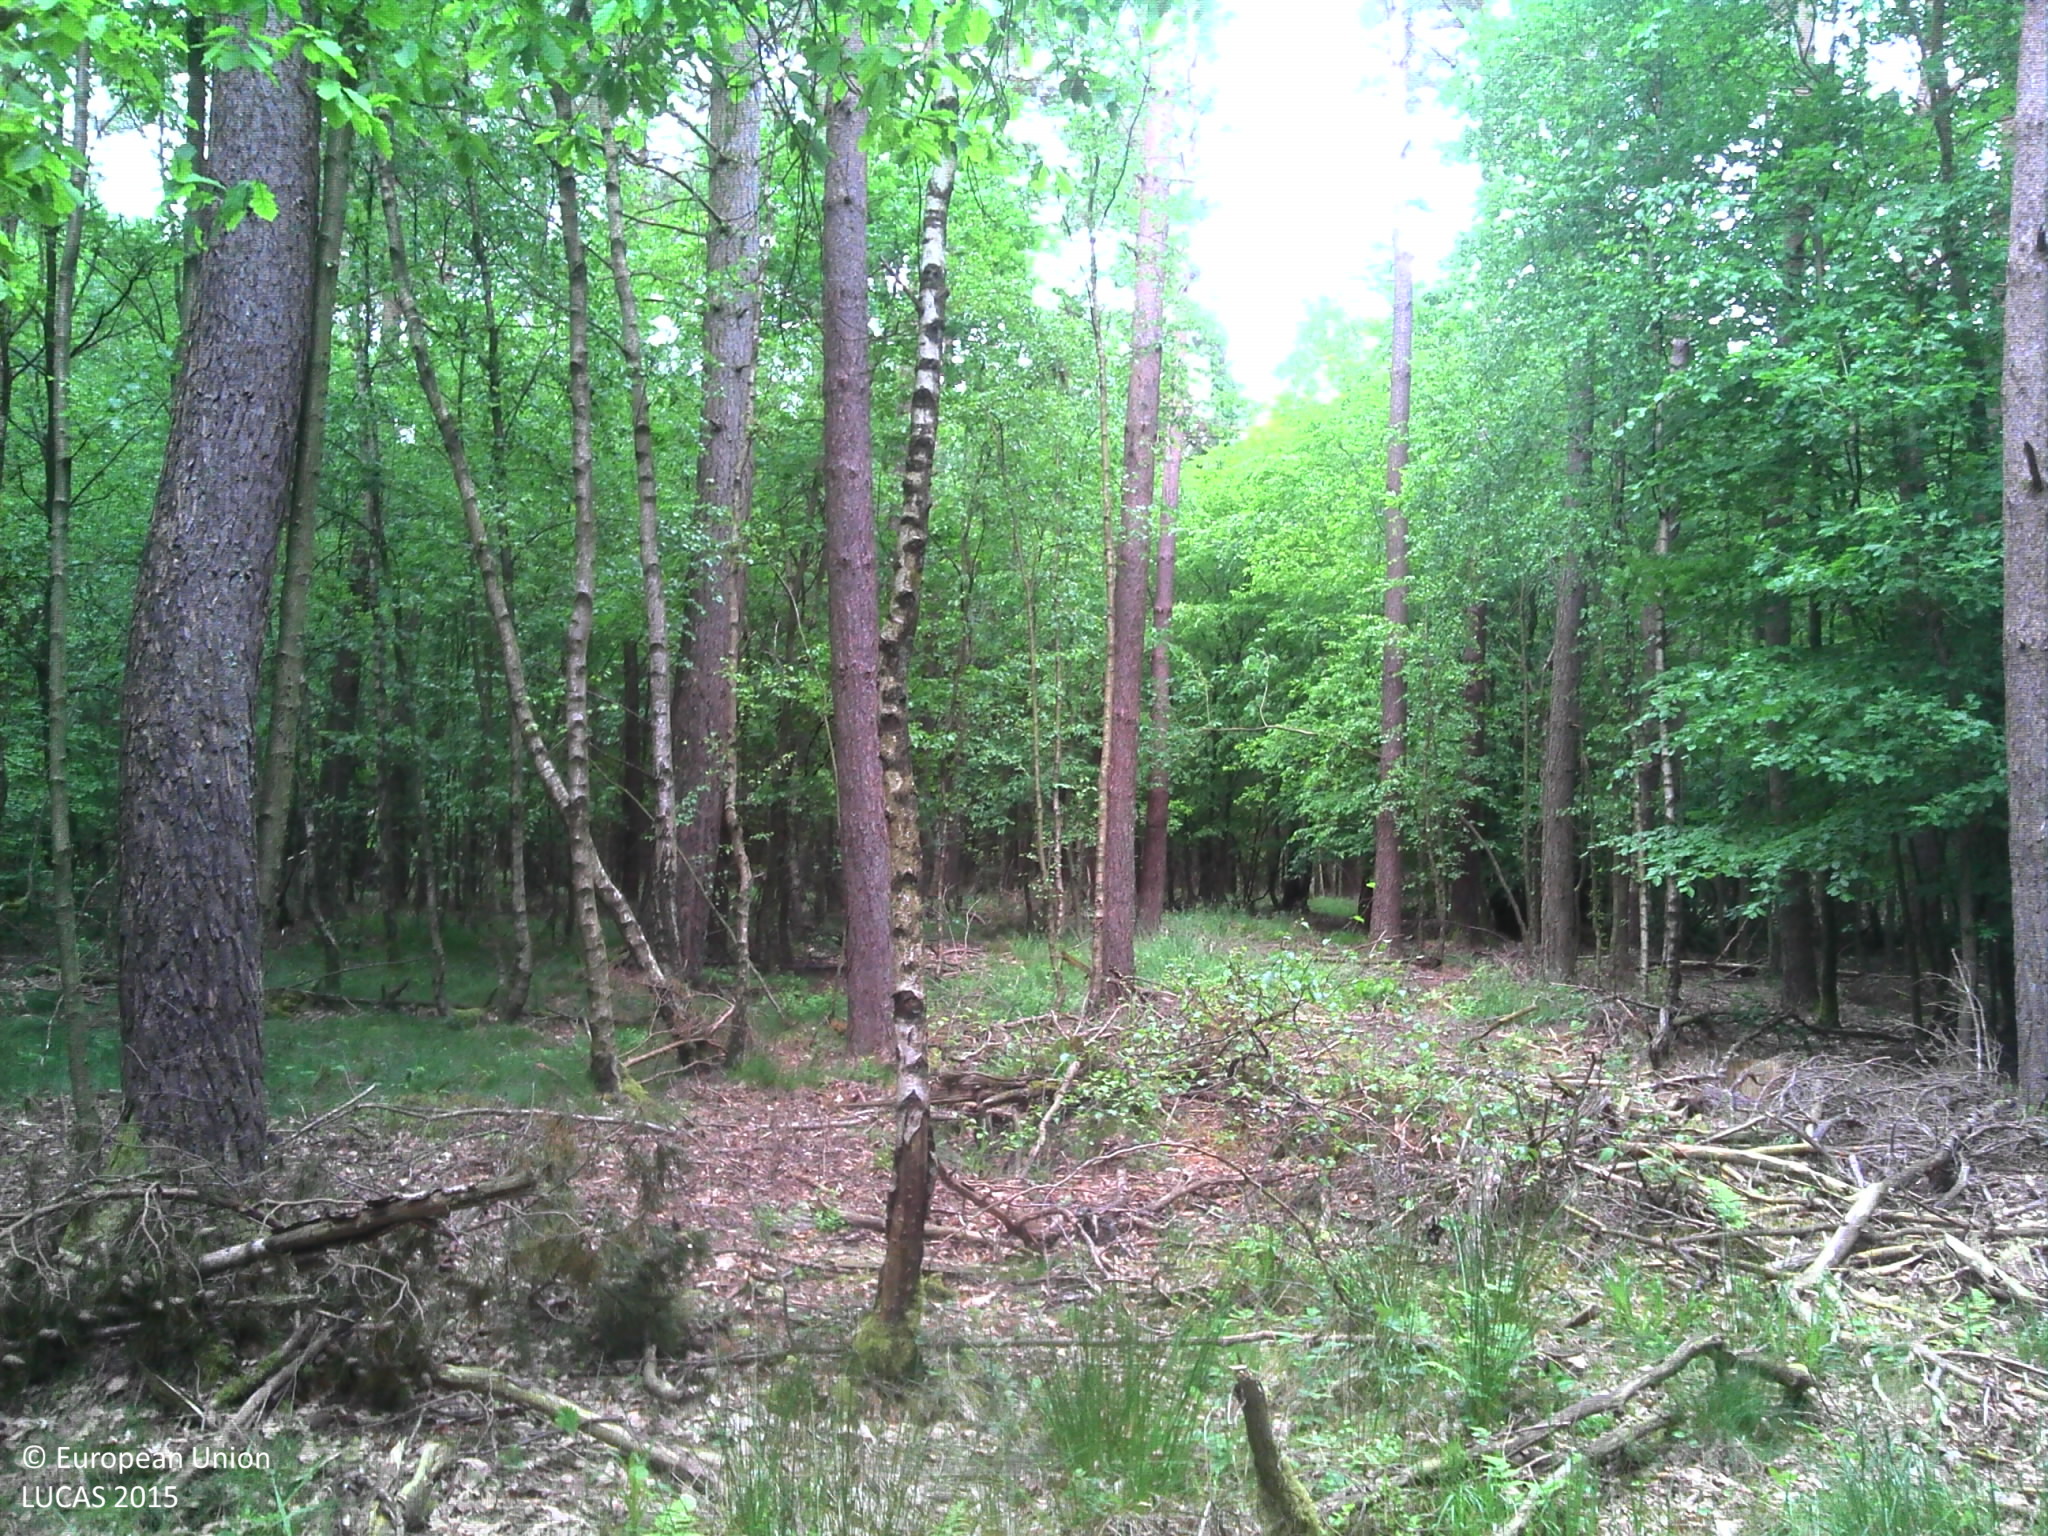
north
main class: Woodland
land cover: Pine dominated mixed woodland
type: hemiboreal forest and nemoral coniferous forest and mixed broadleaved-coniferous forest
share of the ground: > 75 %
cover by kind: broadleaved forest trees 50 %, coniferous forest trees 40 %, herbaceous plants 10 %
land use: Forestry
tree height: > 5 m
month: June
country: BE
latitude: 50.0534
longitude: 4.9272
